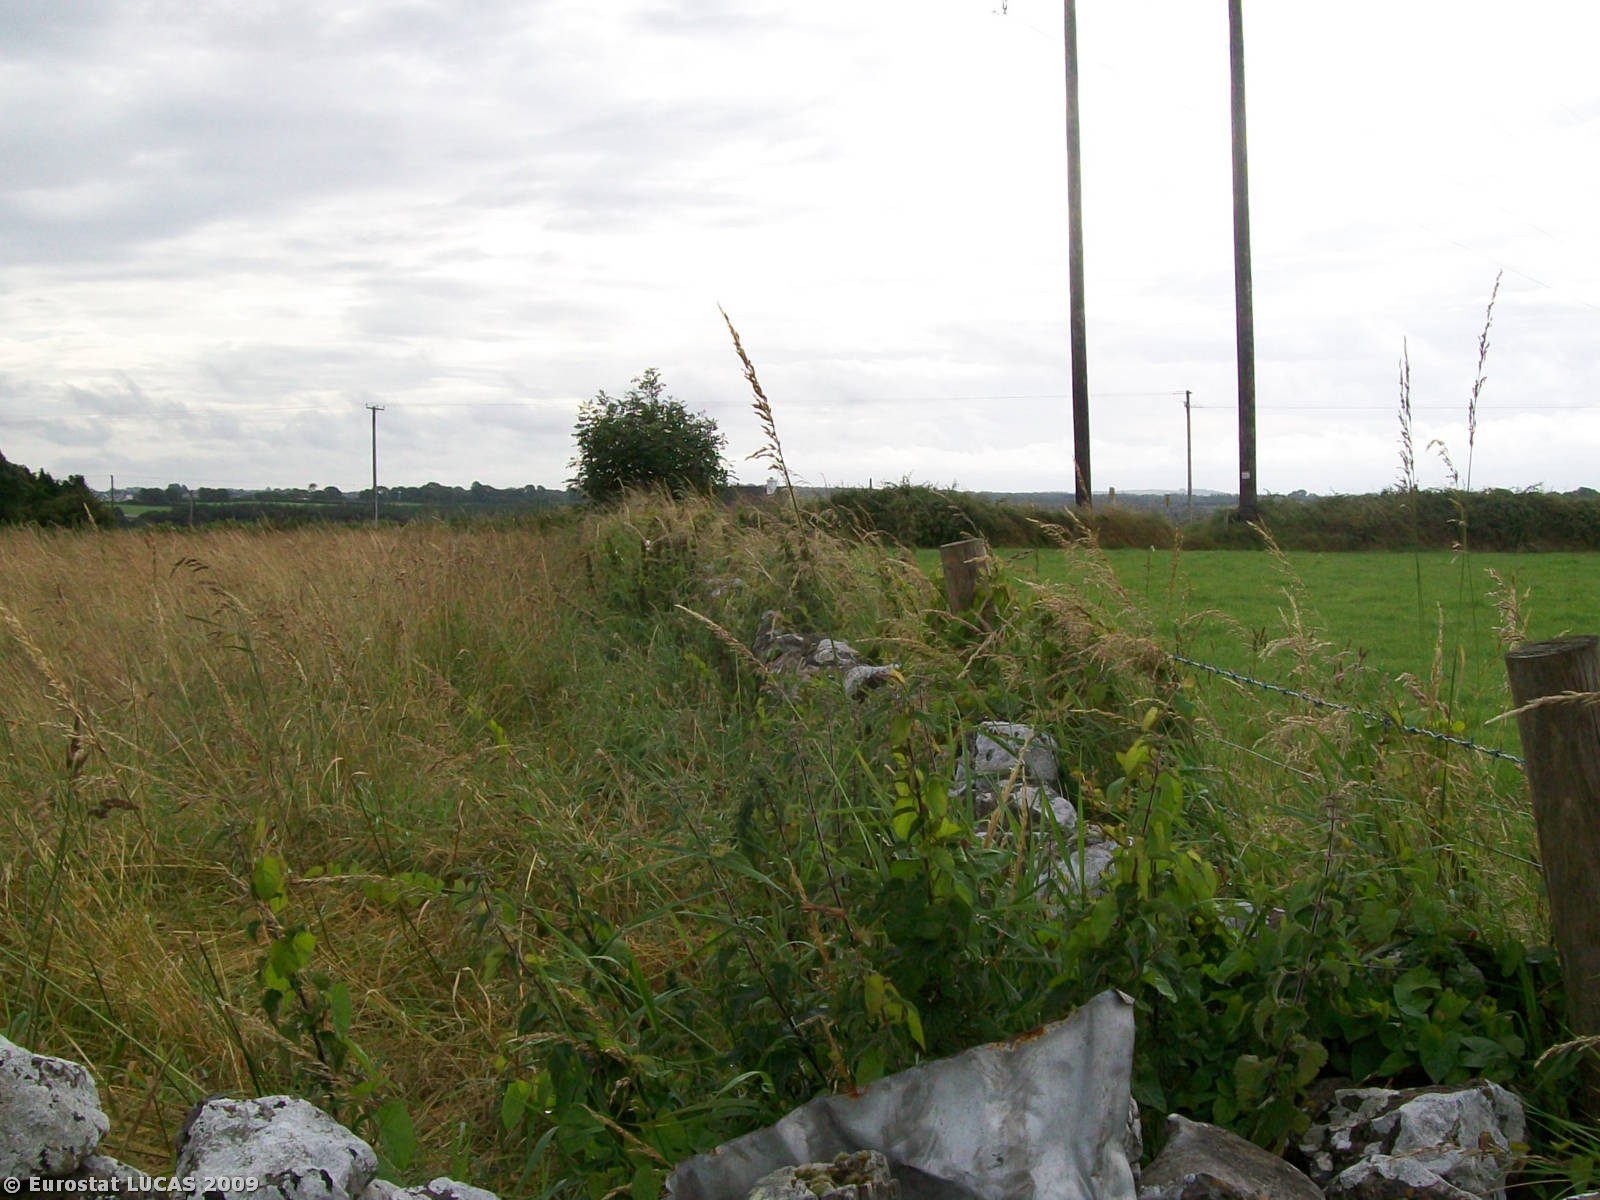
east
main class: Grassland
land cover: Grassland without tree/shrub cover
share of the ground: > 75 %
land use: Agriculture (excluding fallow land and kitchen gardens)
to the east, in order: Grassland without tree/shrub cover; Dry stone walls; Grassland without tree/shrub cover; Electric lines; Dry stone walls; Paved roads, cycling and walking lanes; Dry stone walls; Grassland without tree/shrub cover; Dry stone walls; Grassland without tree/shrub cover
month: July
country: IE
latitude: 53.5046
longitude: -8.8885
